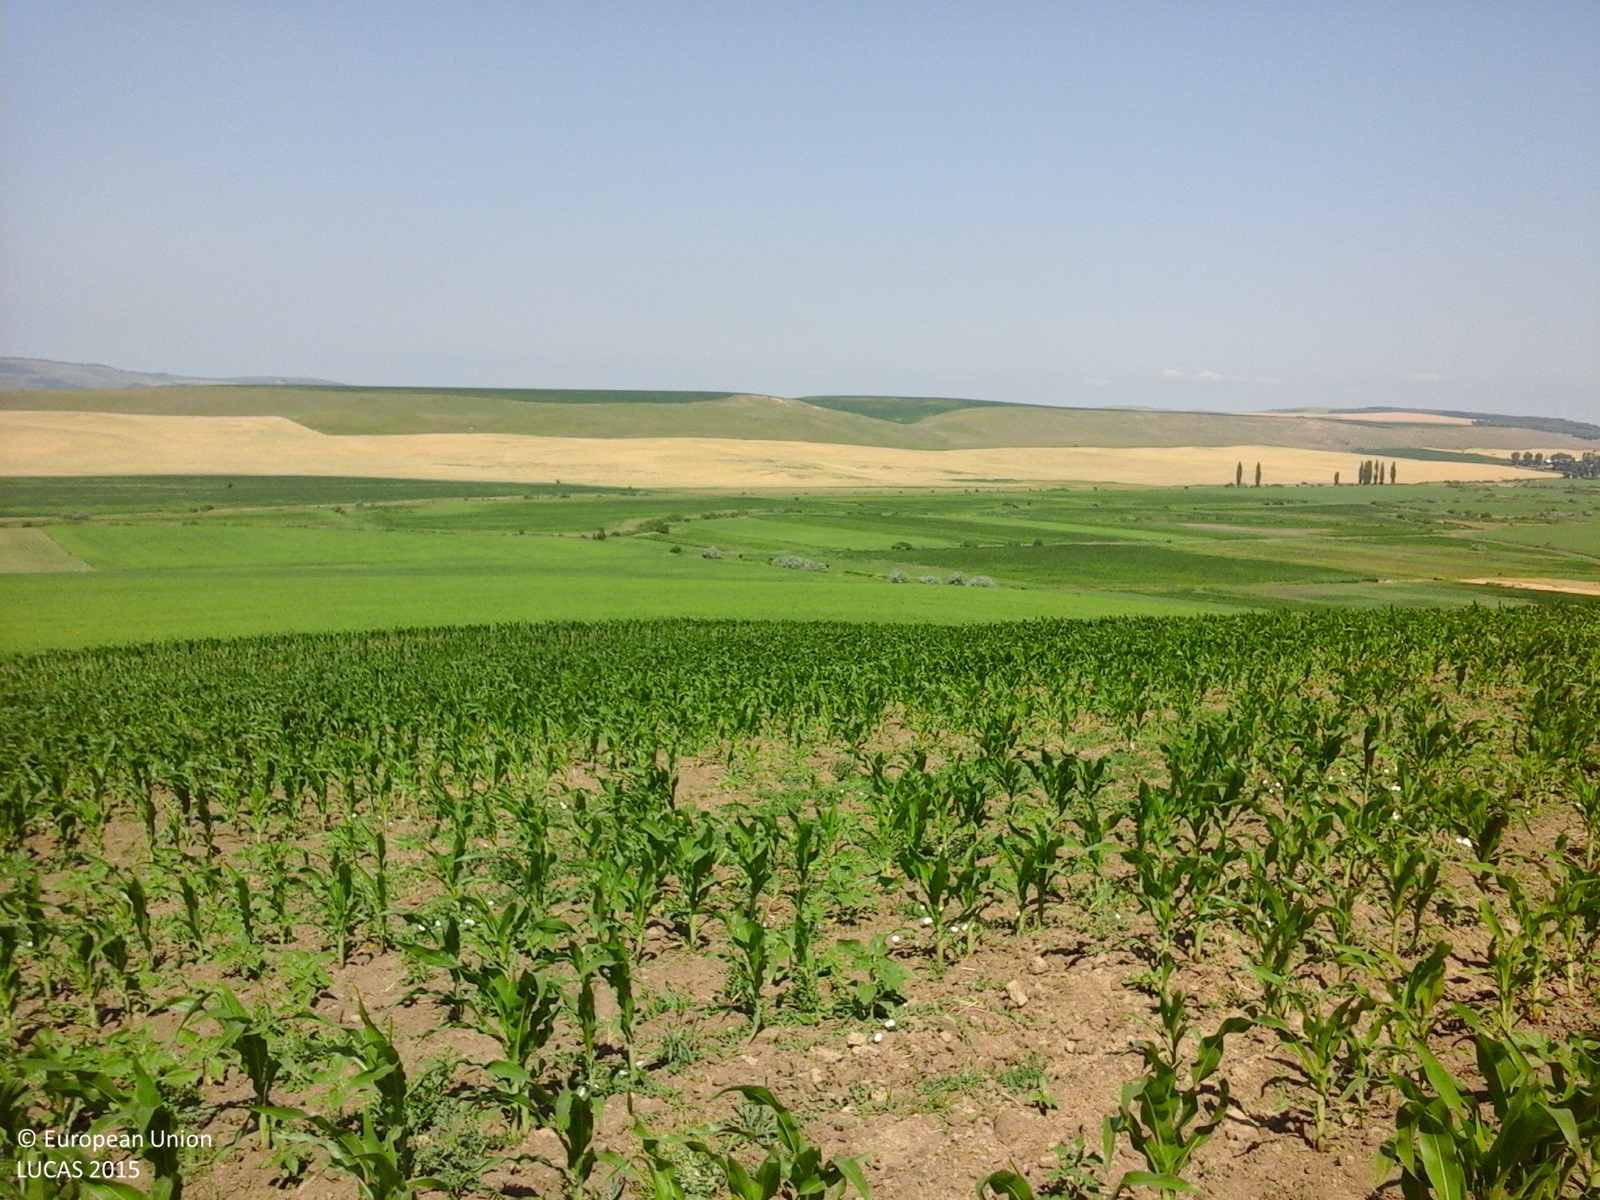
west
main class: Cropland
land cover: Maize
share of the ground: 25 - 50 %
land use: Agriculture (excluding fallow land and kitchen gardens)
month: June
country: RO
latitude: 46.8921
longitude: 27.7752
